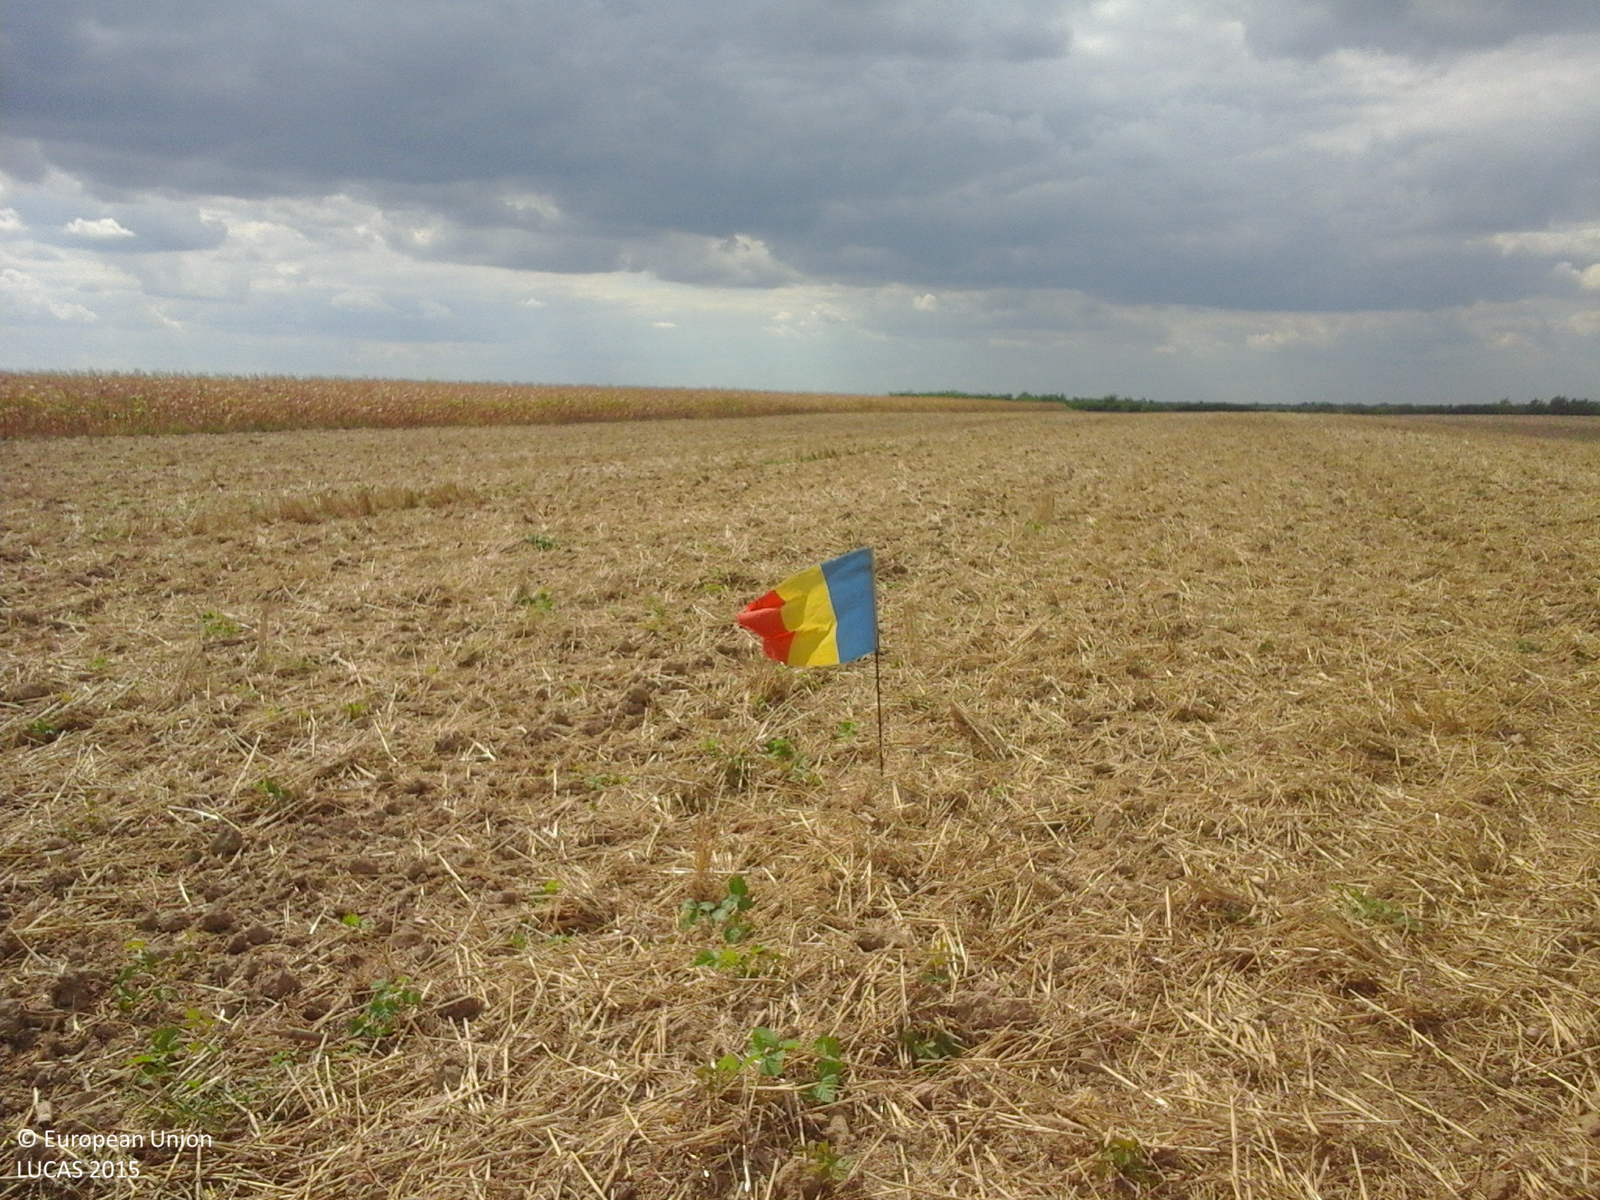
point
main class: Cropland
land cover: Common wheat
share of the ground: 25 - 50 %
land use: Agriculture (excluding fallow land and kitchen gardens)
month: September
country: RO
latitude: 47.8707
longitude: 22.8319
